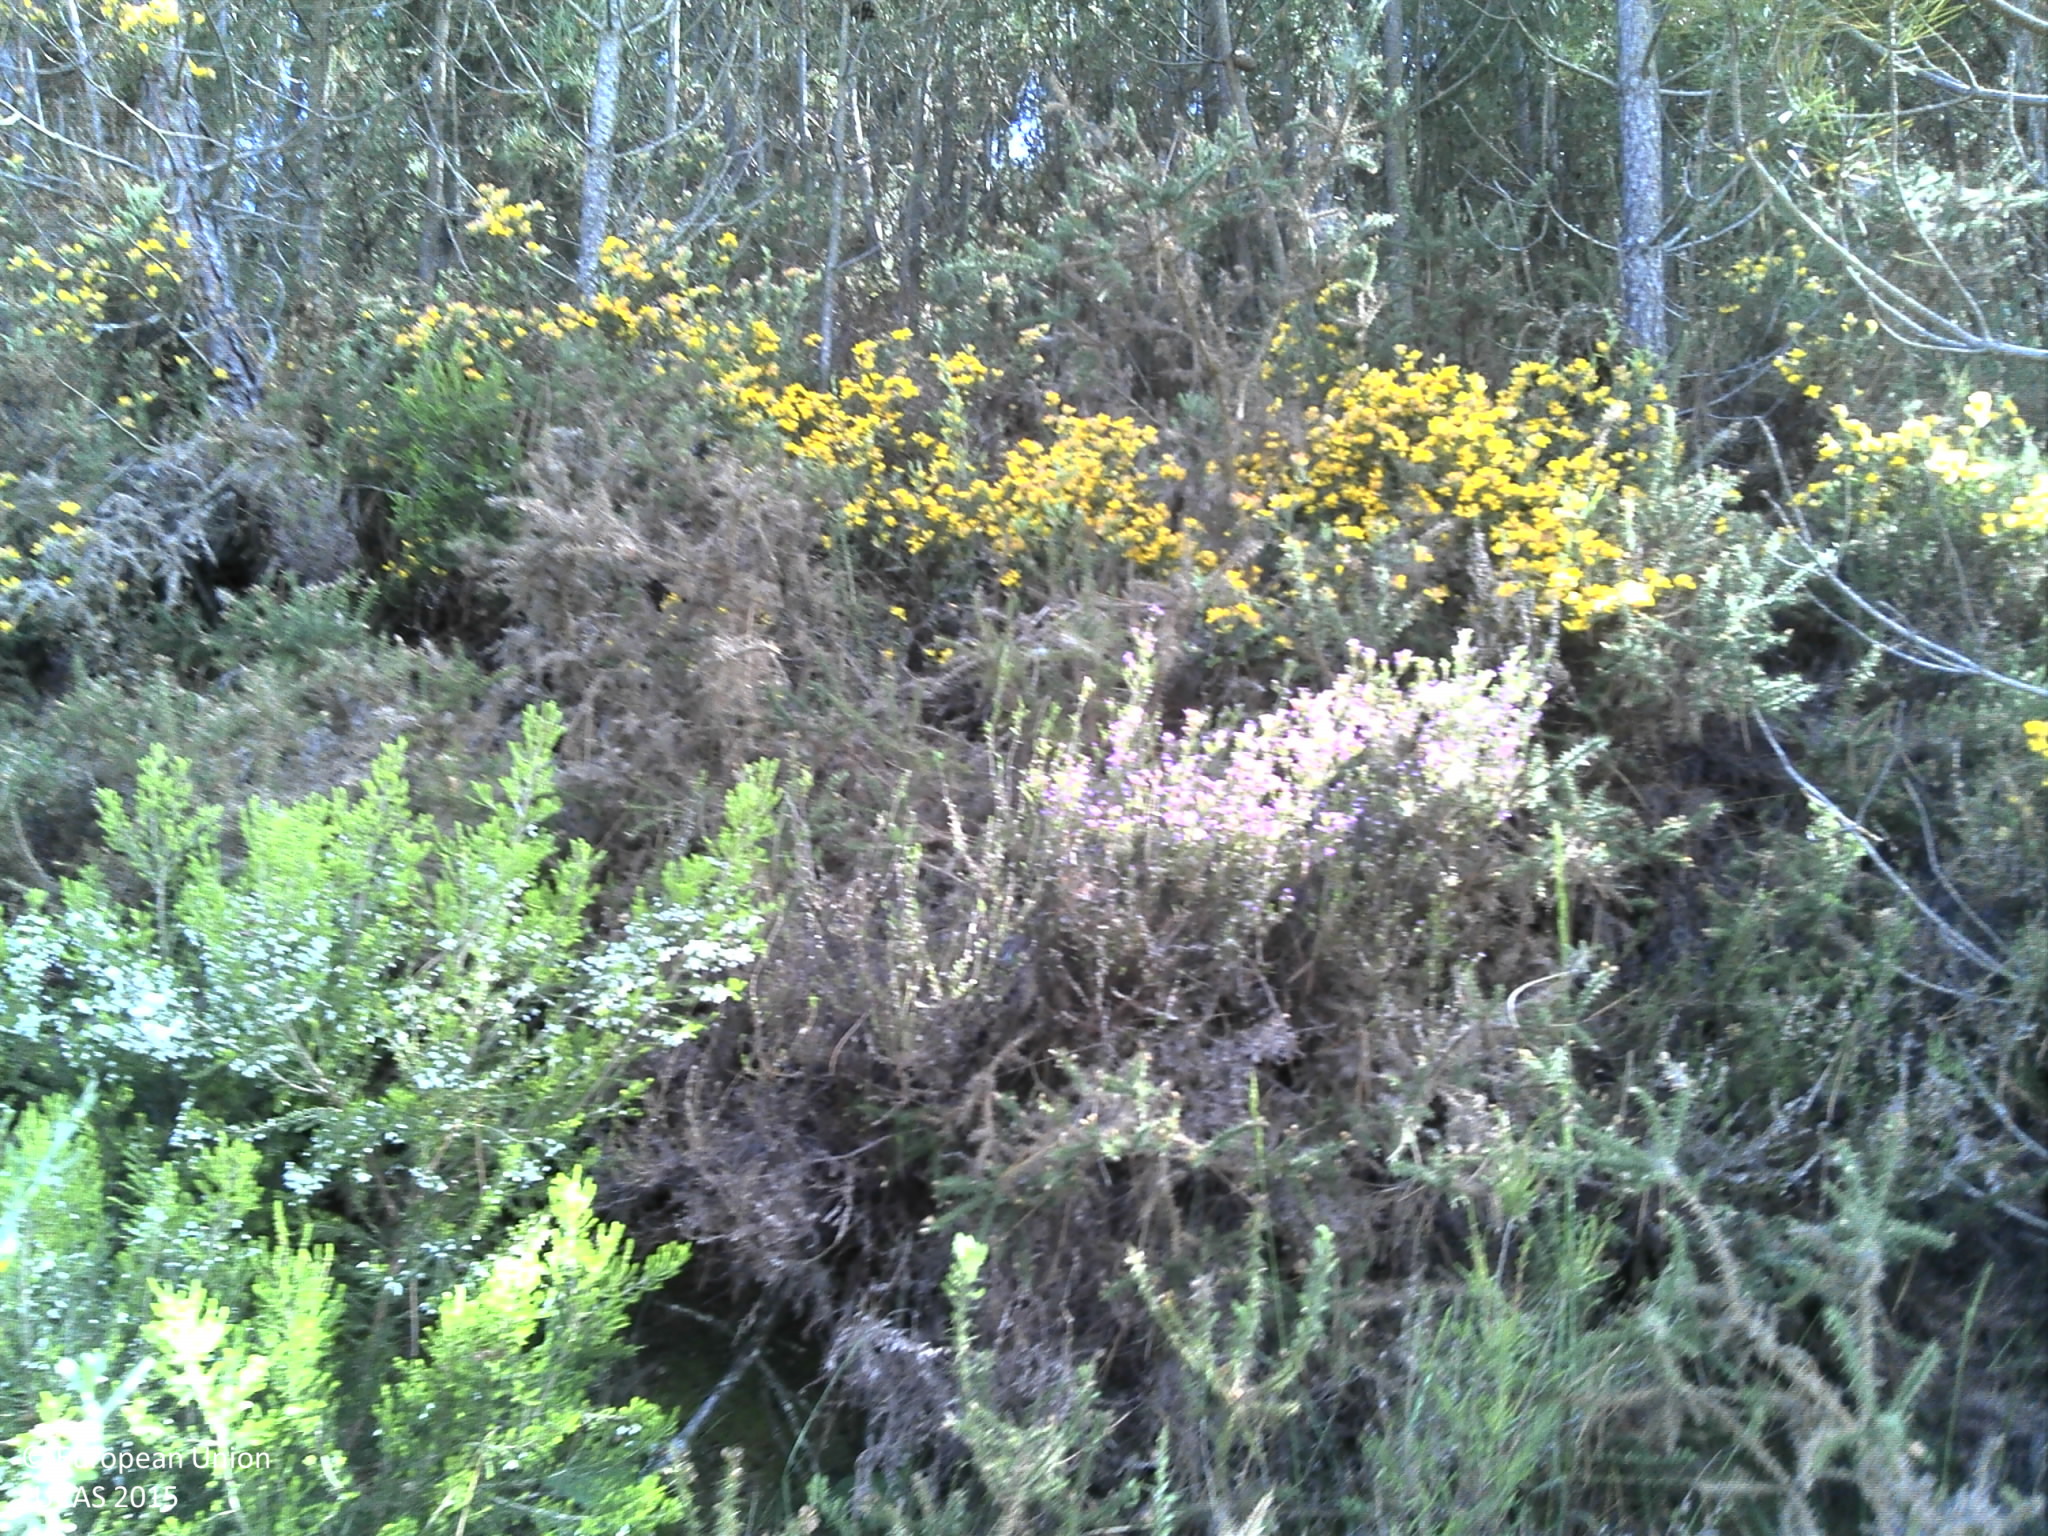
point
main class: Woodland
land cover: Pine dominated coniferous woodland
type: coniferous forest of the mediterranean region
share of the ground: > 75 %
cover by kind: coniferous forest trees 60 %, shrubs 35 %, unconsolidated bare surface 5 %
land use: Forestry
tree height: < 5 m
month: May
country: PT
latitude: 41.5068
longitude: -7.5855
